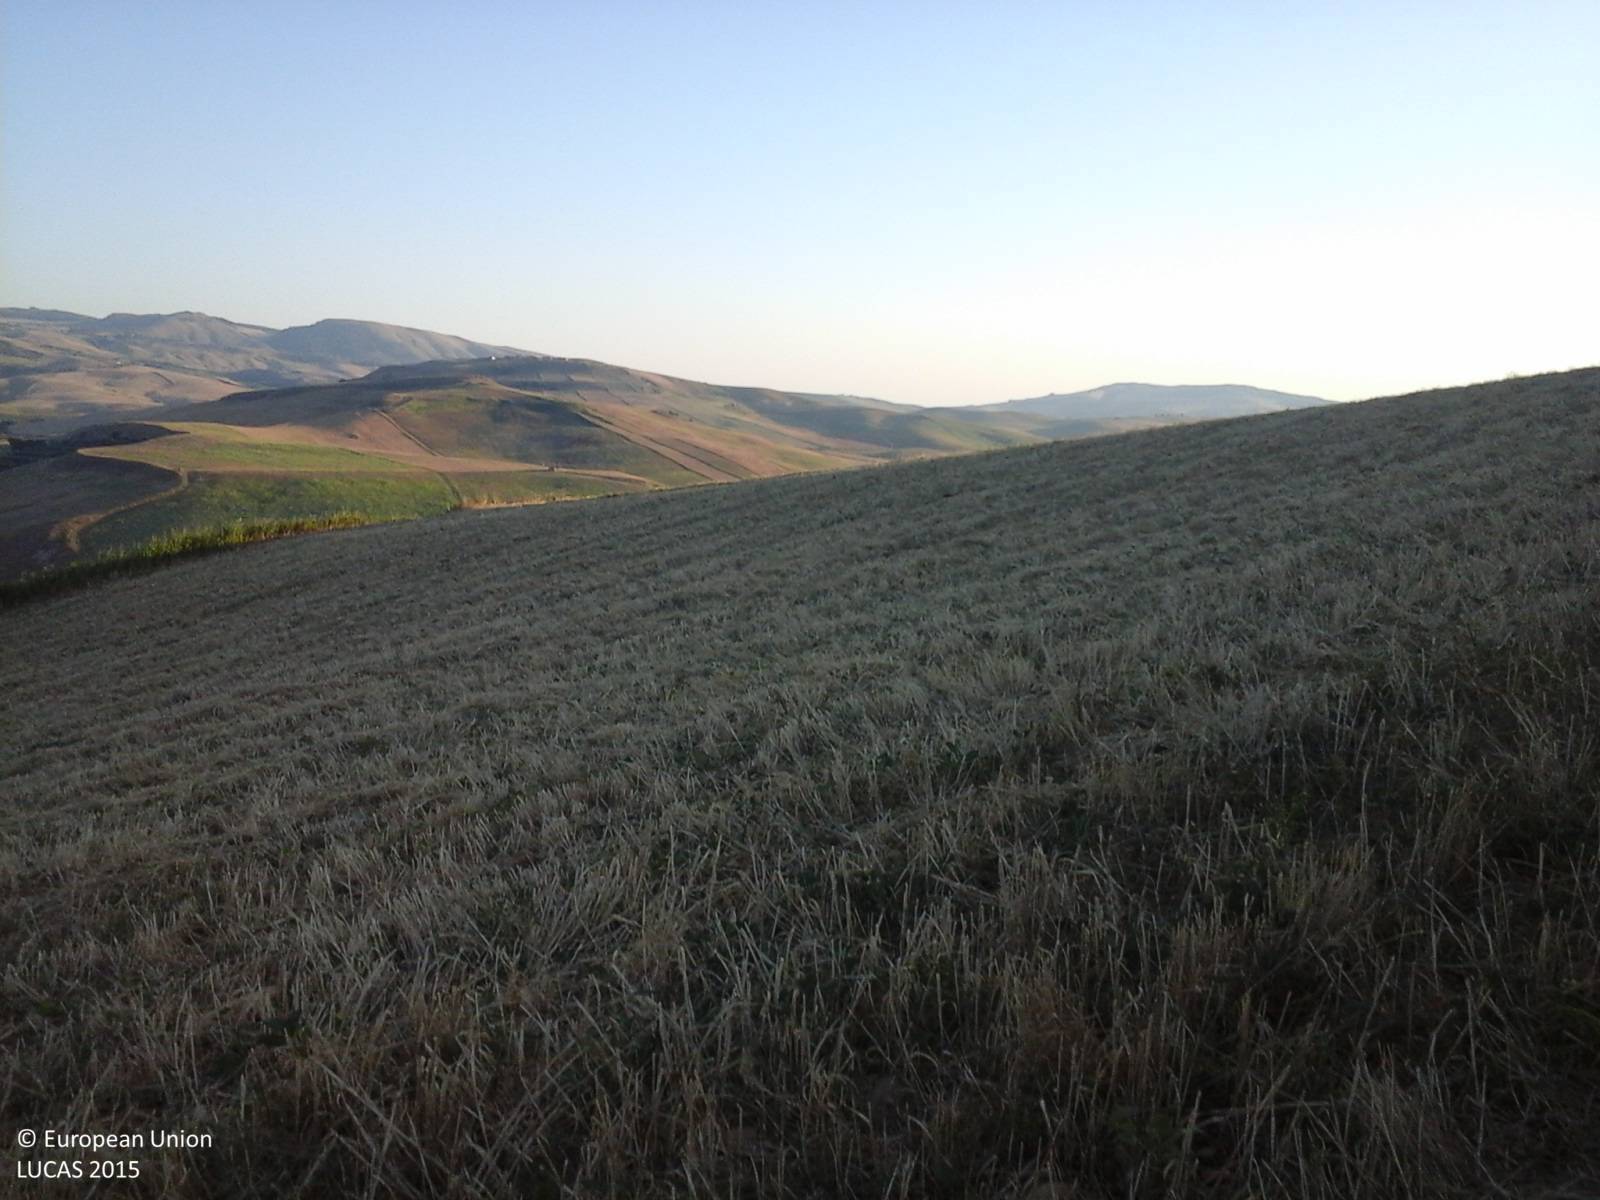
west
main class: Grassland
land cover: Grassland without tree/shrub cover
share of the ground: > 75 %
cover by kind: herbaceous plants 100 %
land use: Agriculture (excluding fallow land and kitchen gardens)
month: July
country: IT
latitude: 37.7849
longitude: 13.1899
